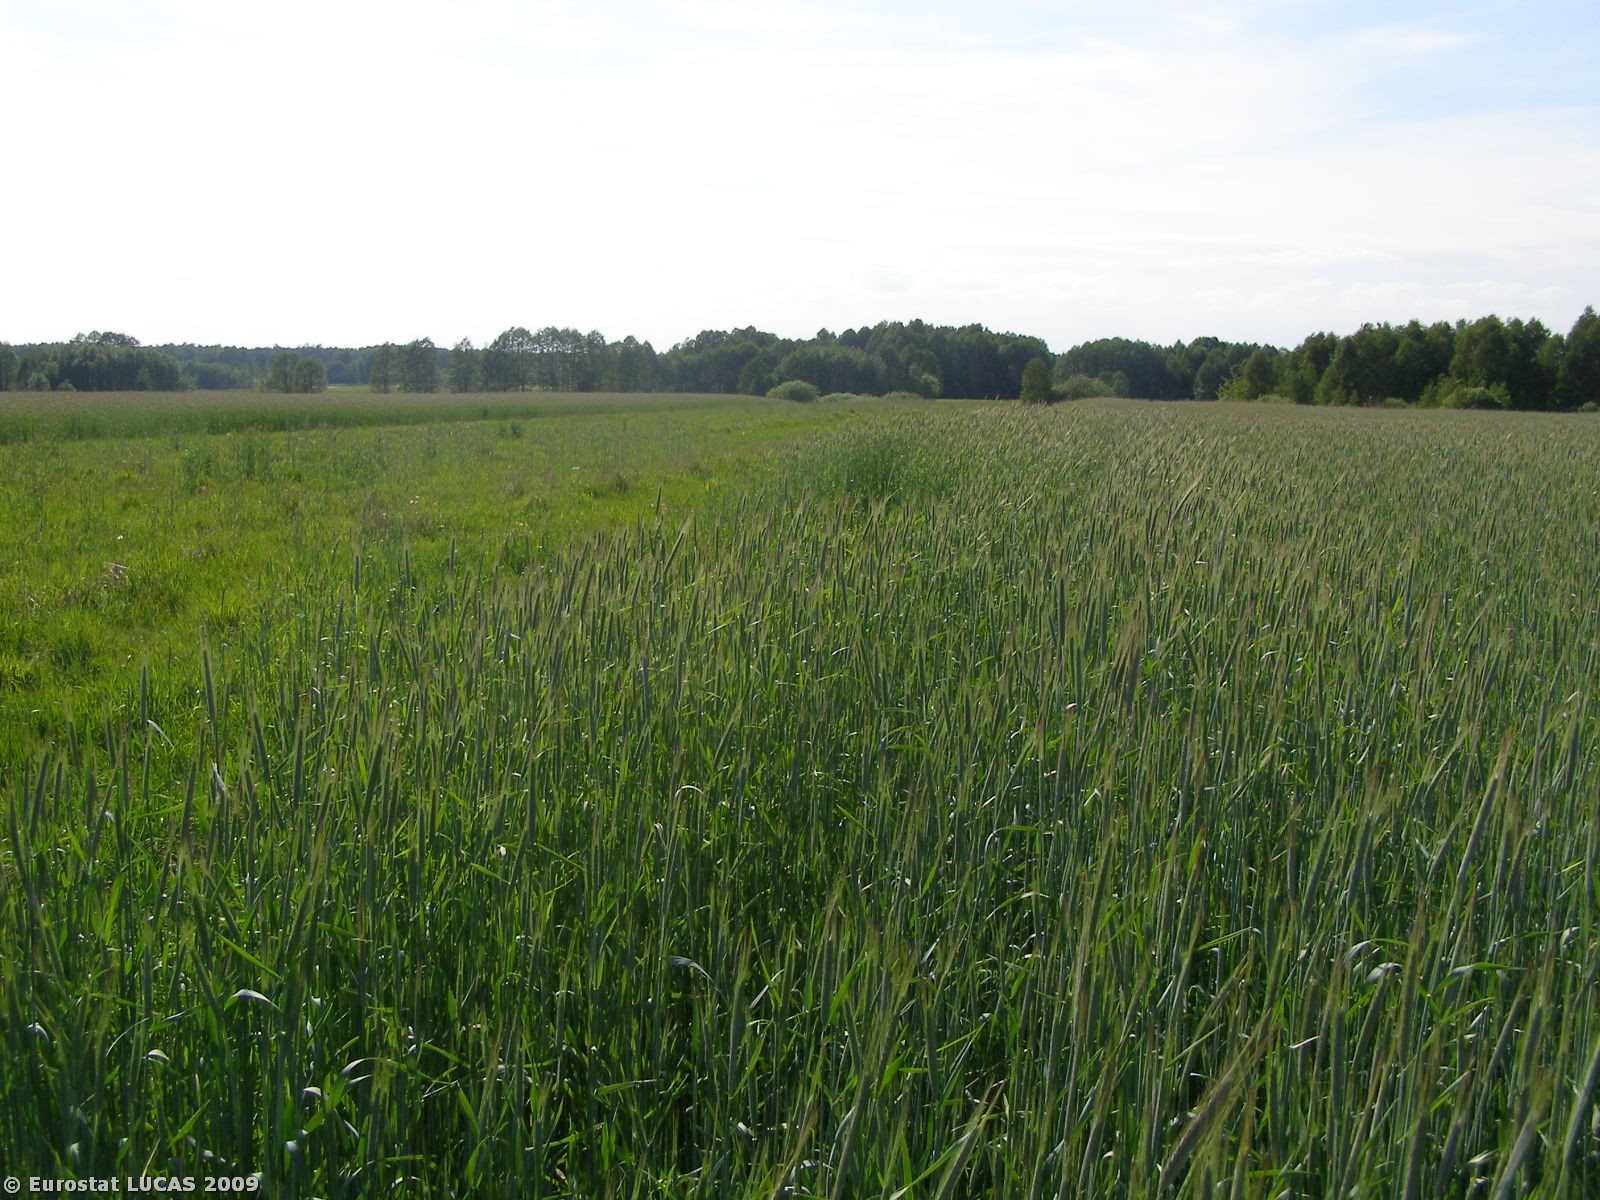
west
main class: Cropland
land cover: Rye
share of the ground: > 75 %
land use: Agriculture (excluding fallow land and kitchen gardens)
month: May
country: PL
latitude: 51.0871
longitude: 23.8393
